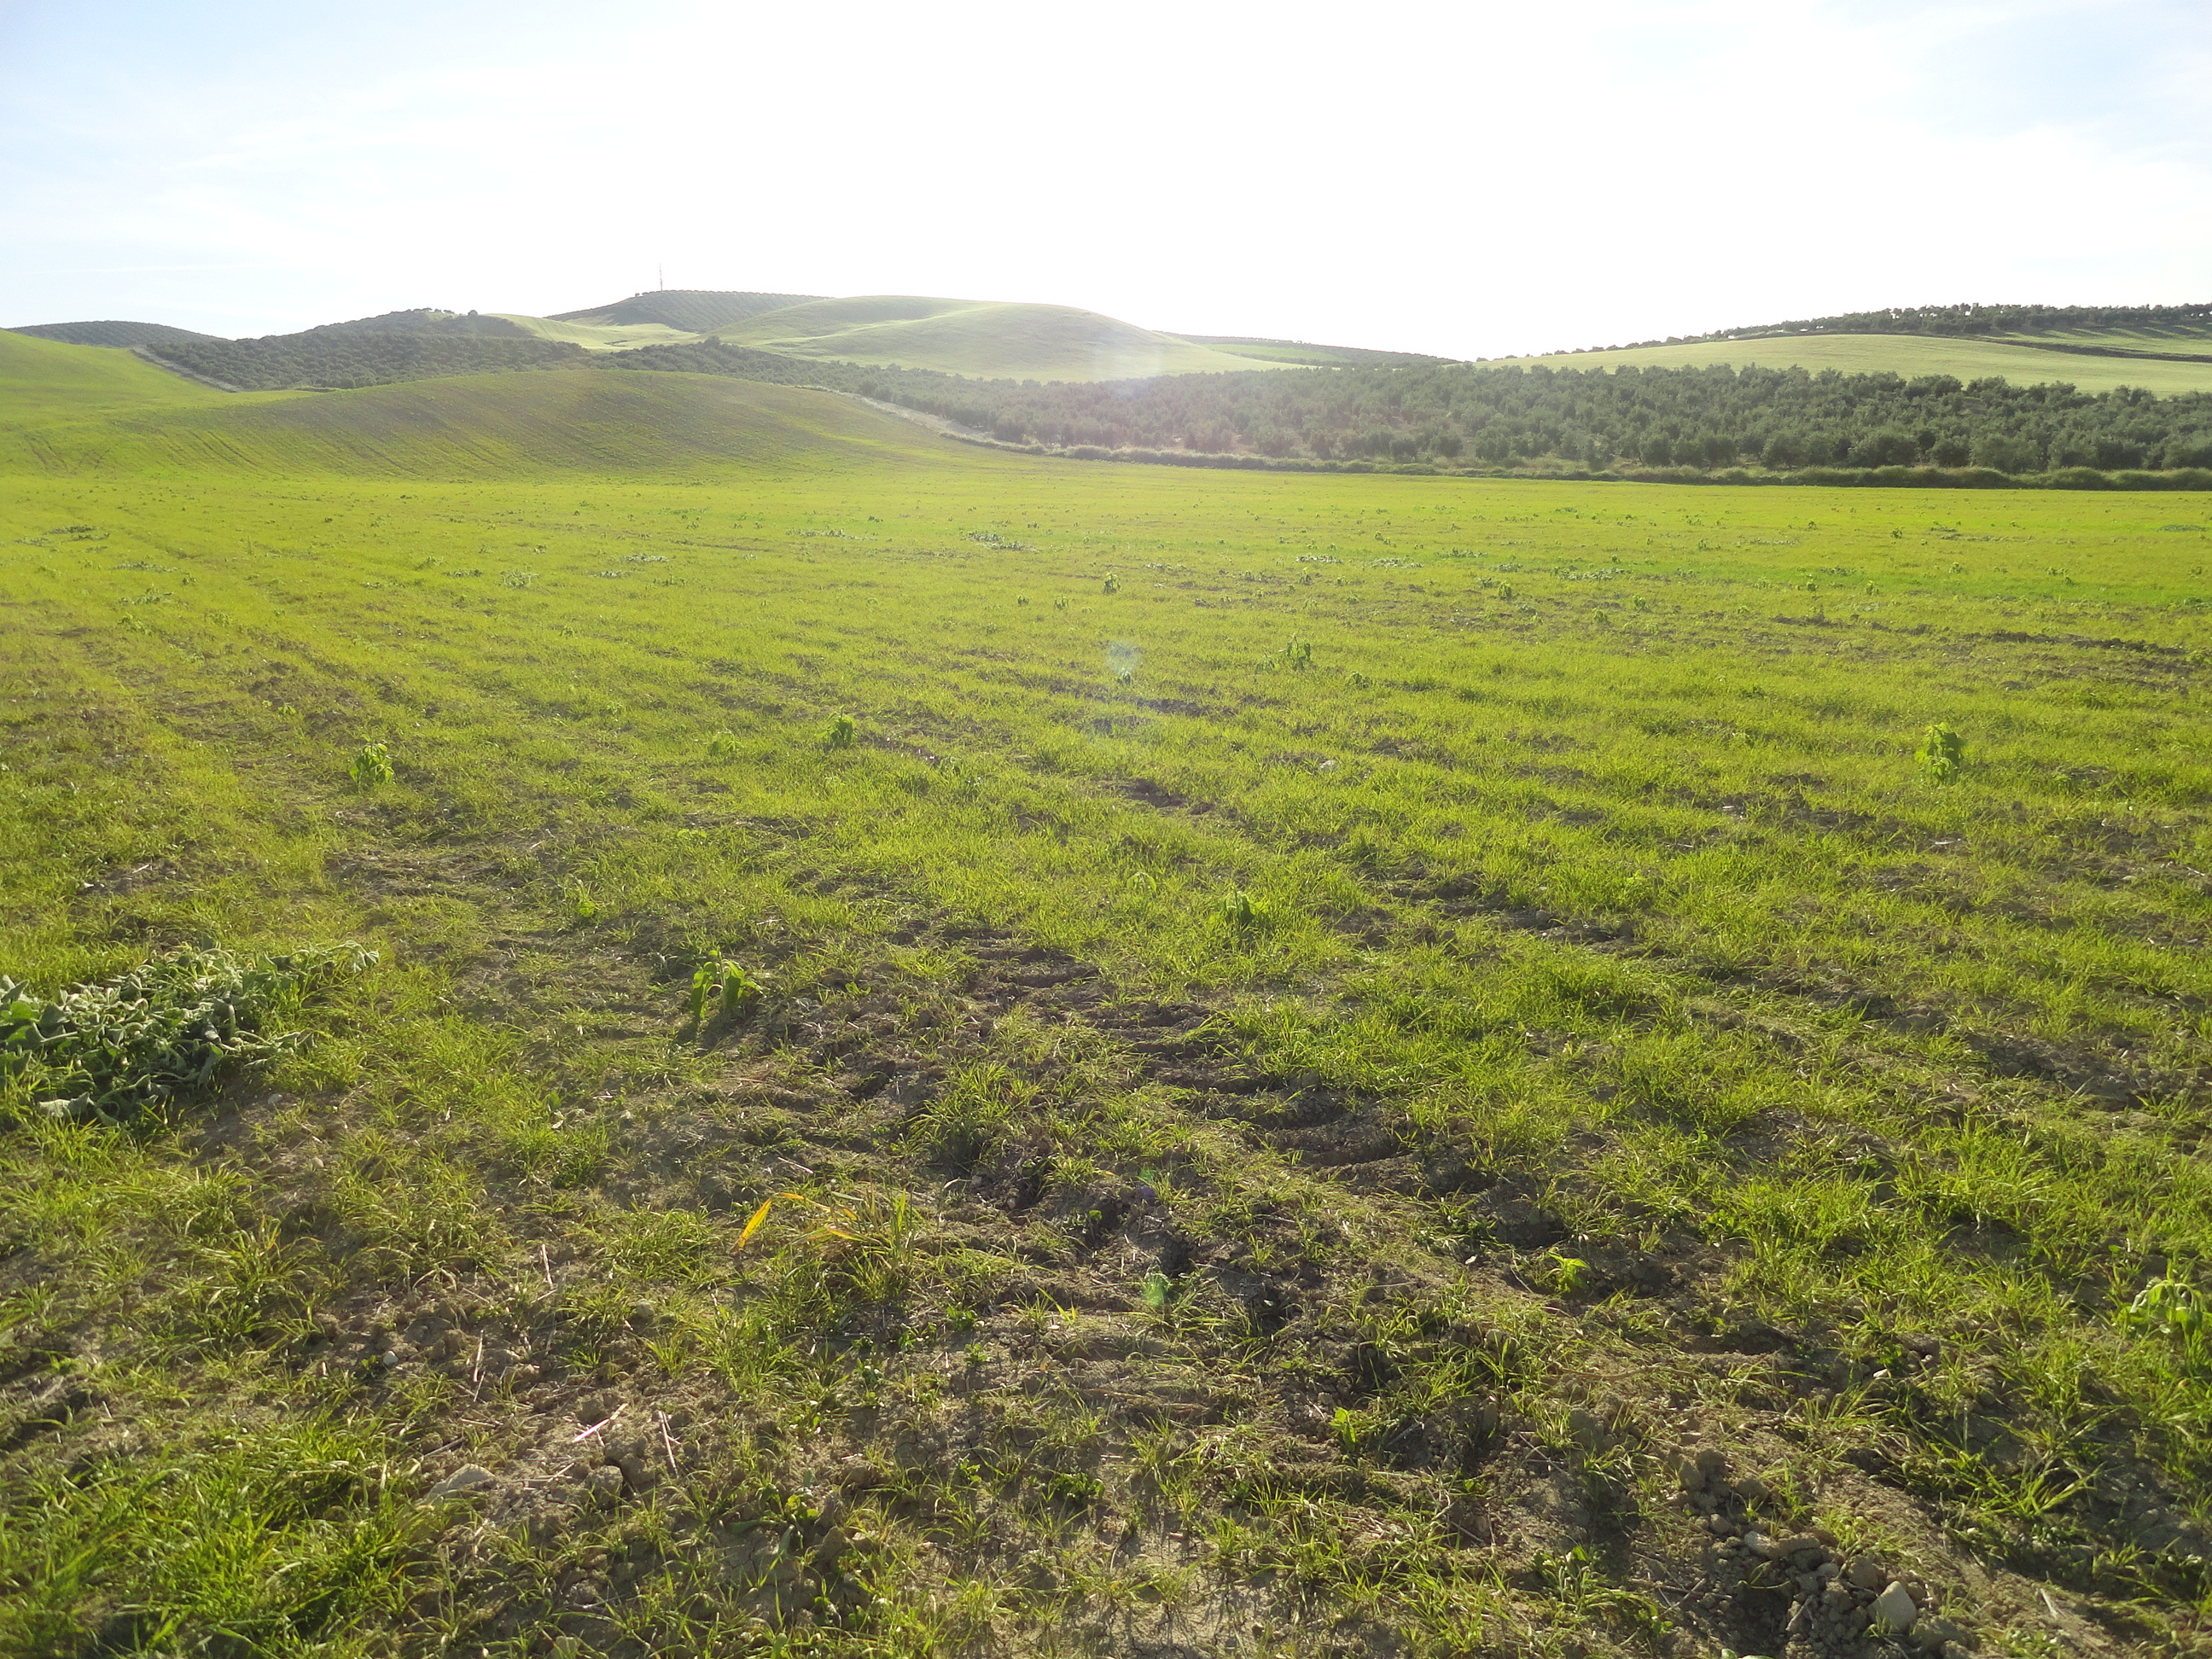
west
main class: Grassland
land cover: Spontaneously vegetated surfaces
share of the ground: 50 - 75 %
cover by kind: herbaceous plants 80 %, unconsolidated bare surface 20 %
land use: Fallow land
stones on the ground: < 10 %
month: April
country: ES
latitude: 37.6942
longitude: -4.5129
